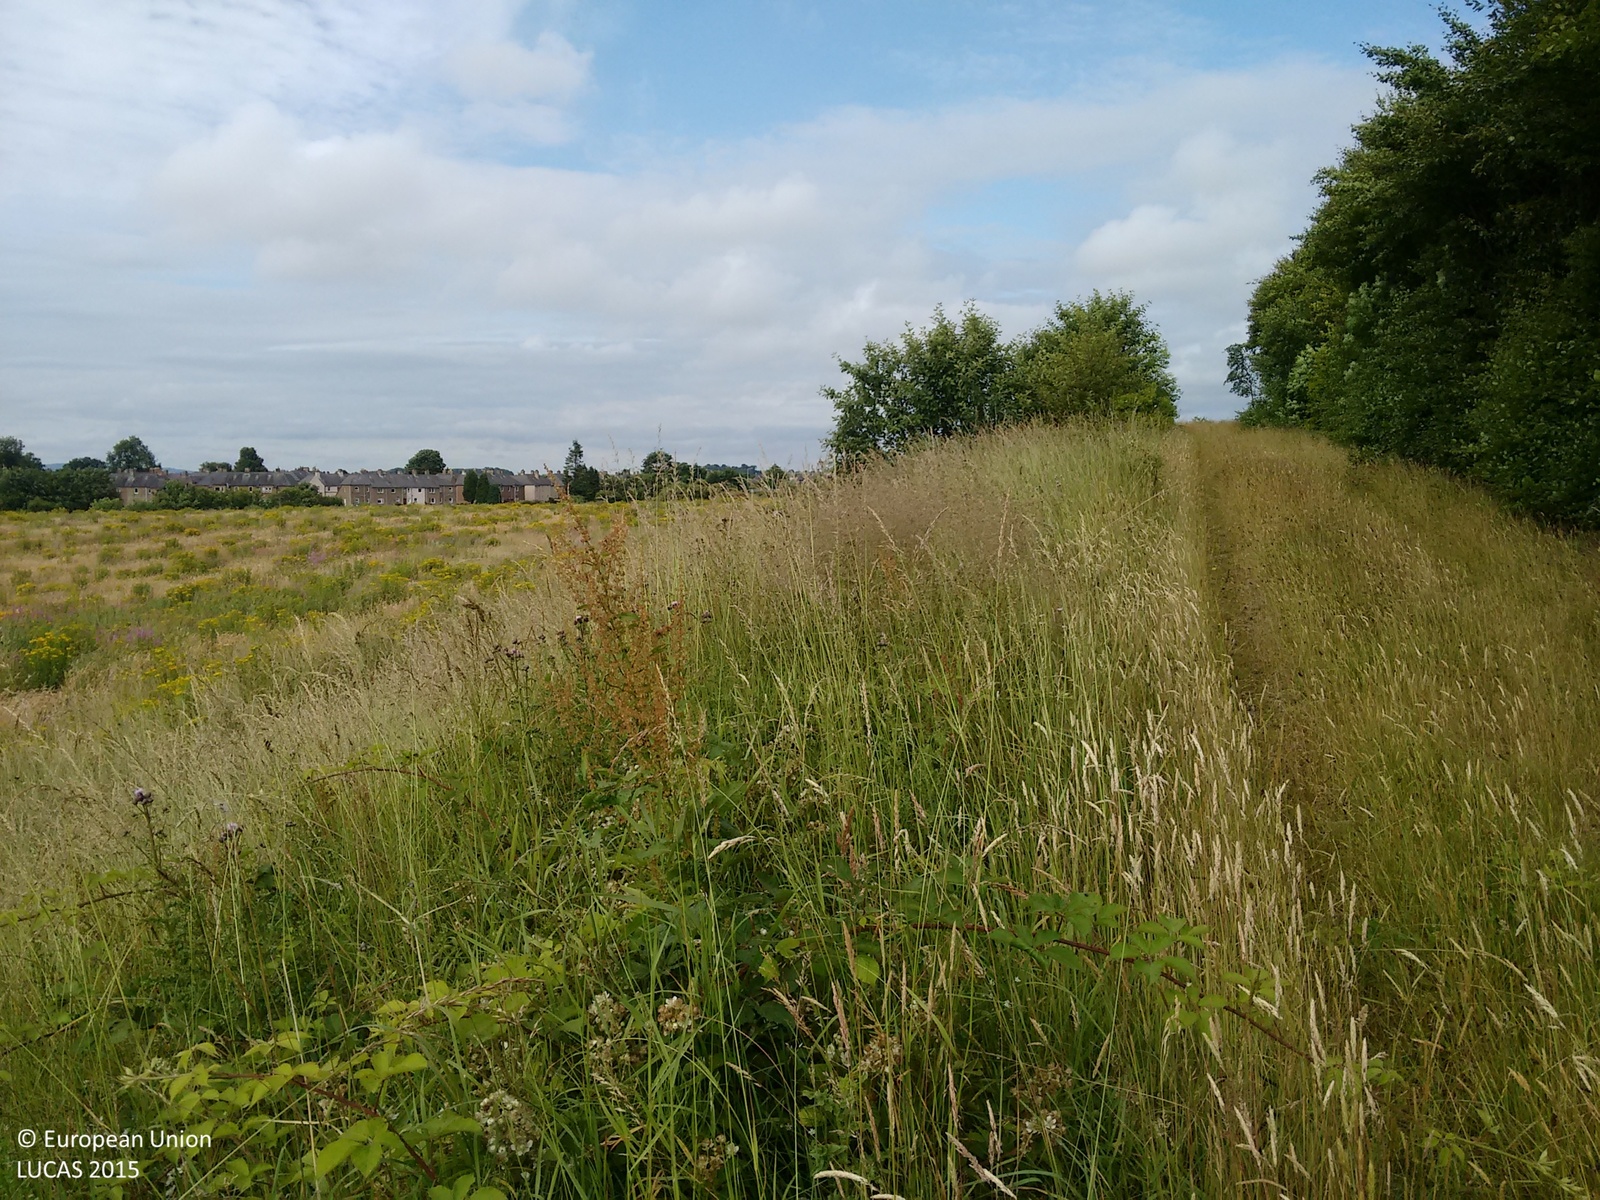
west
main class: Grassland
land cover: Grassland without tree/shrub cover
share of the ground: > 75 %
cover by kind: herbaceous plants 100 %
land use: Semi-natural and natural areas not in use
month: July
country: GB
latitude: 56.0449
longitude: -3.4157
